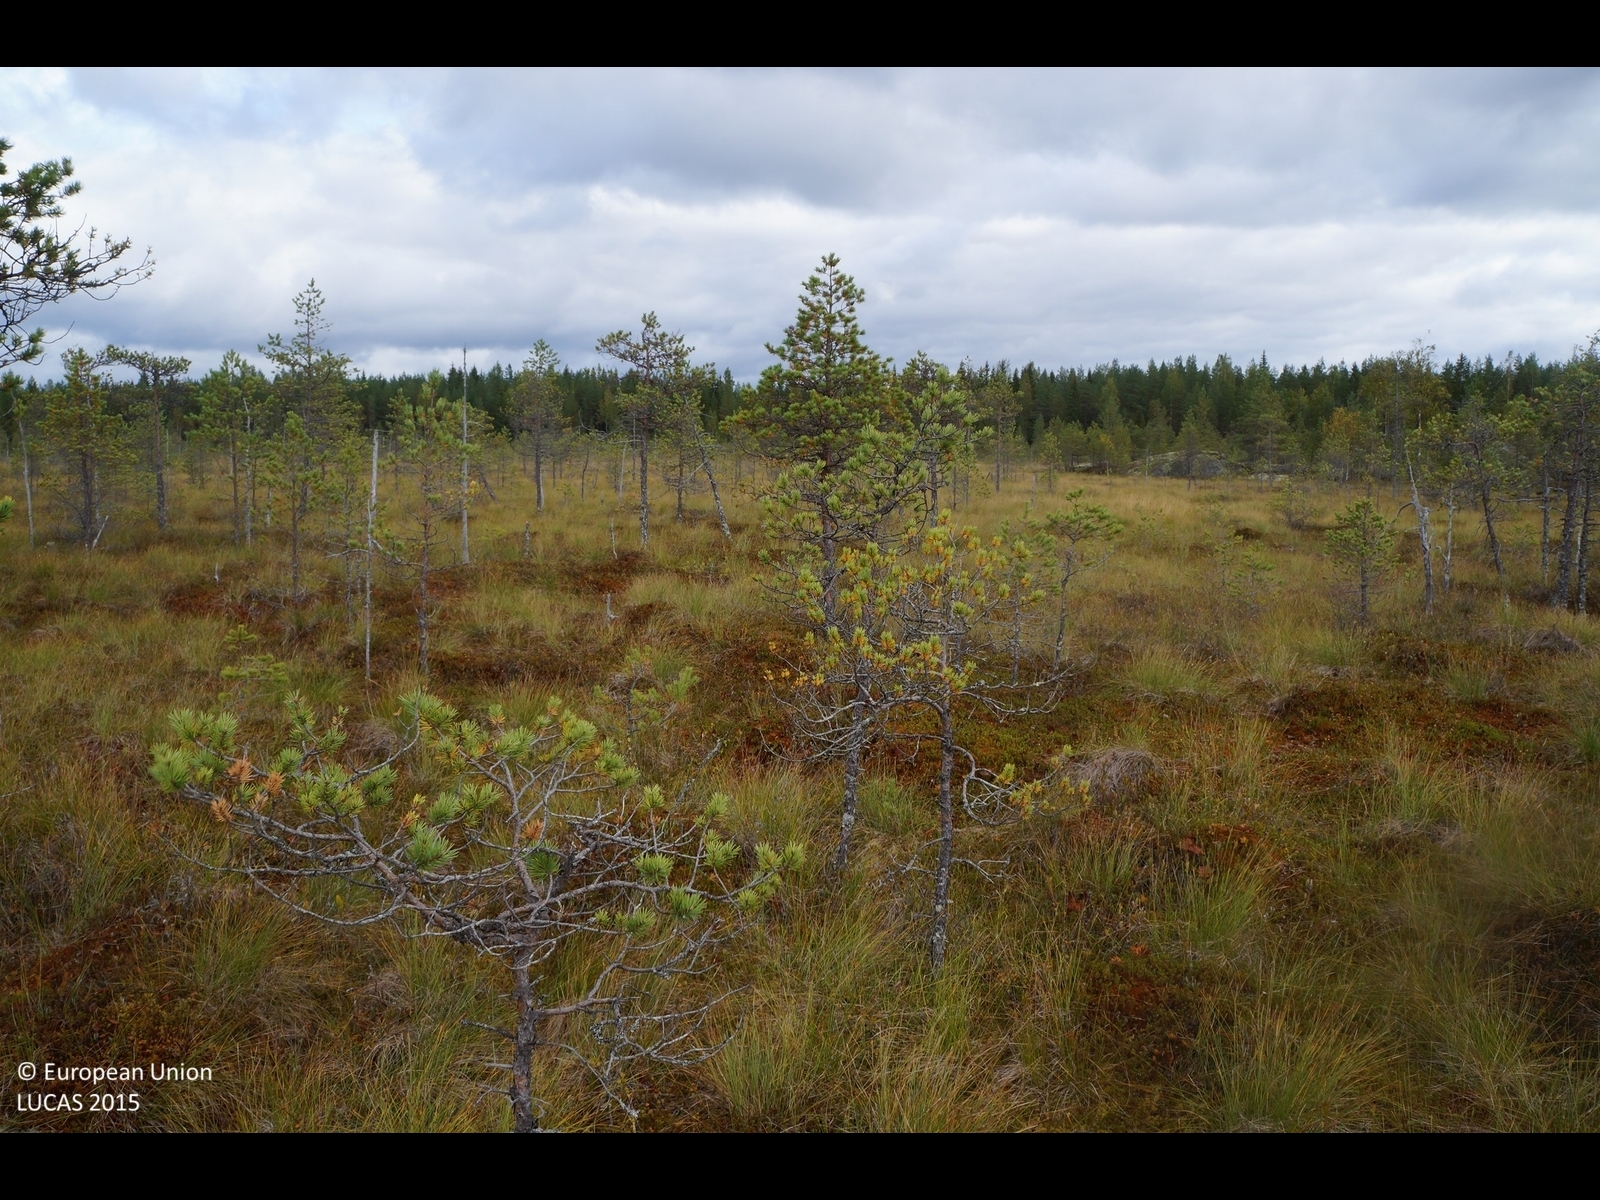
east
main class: Woodland
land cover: Pine dominated coniferous woodland
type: boreal forest
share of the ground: 10 - 25 %
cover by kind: herbaceous plants 40 %, lichens and mosses 30 %, coniferous forest trees 20 %, shrubs 10 %
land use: Semi-natural and natural areas not in use
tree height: < 5 m
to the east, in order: Pine dominated coniferous woodland; Peatbogs; Pine dominated coniferous woodland; Peatbogs; Pine dominated coniferous woodland
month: September
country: FI
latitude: 64.0267
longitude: 24.2522
